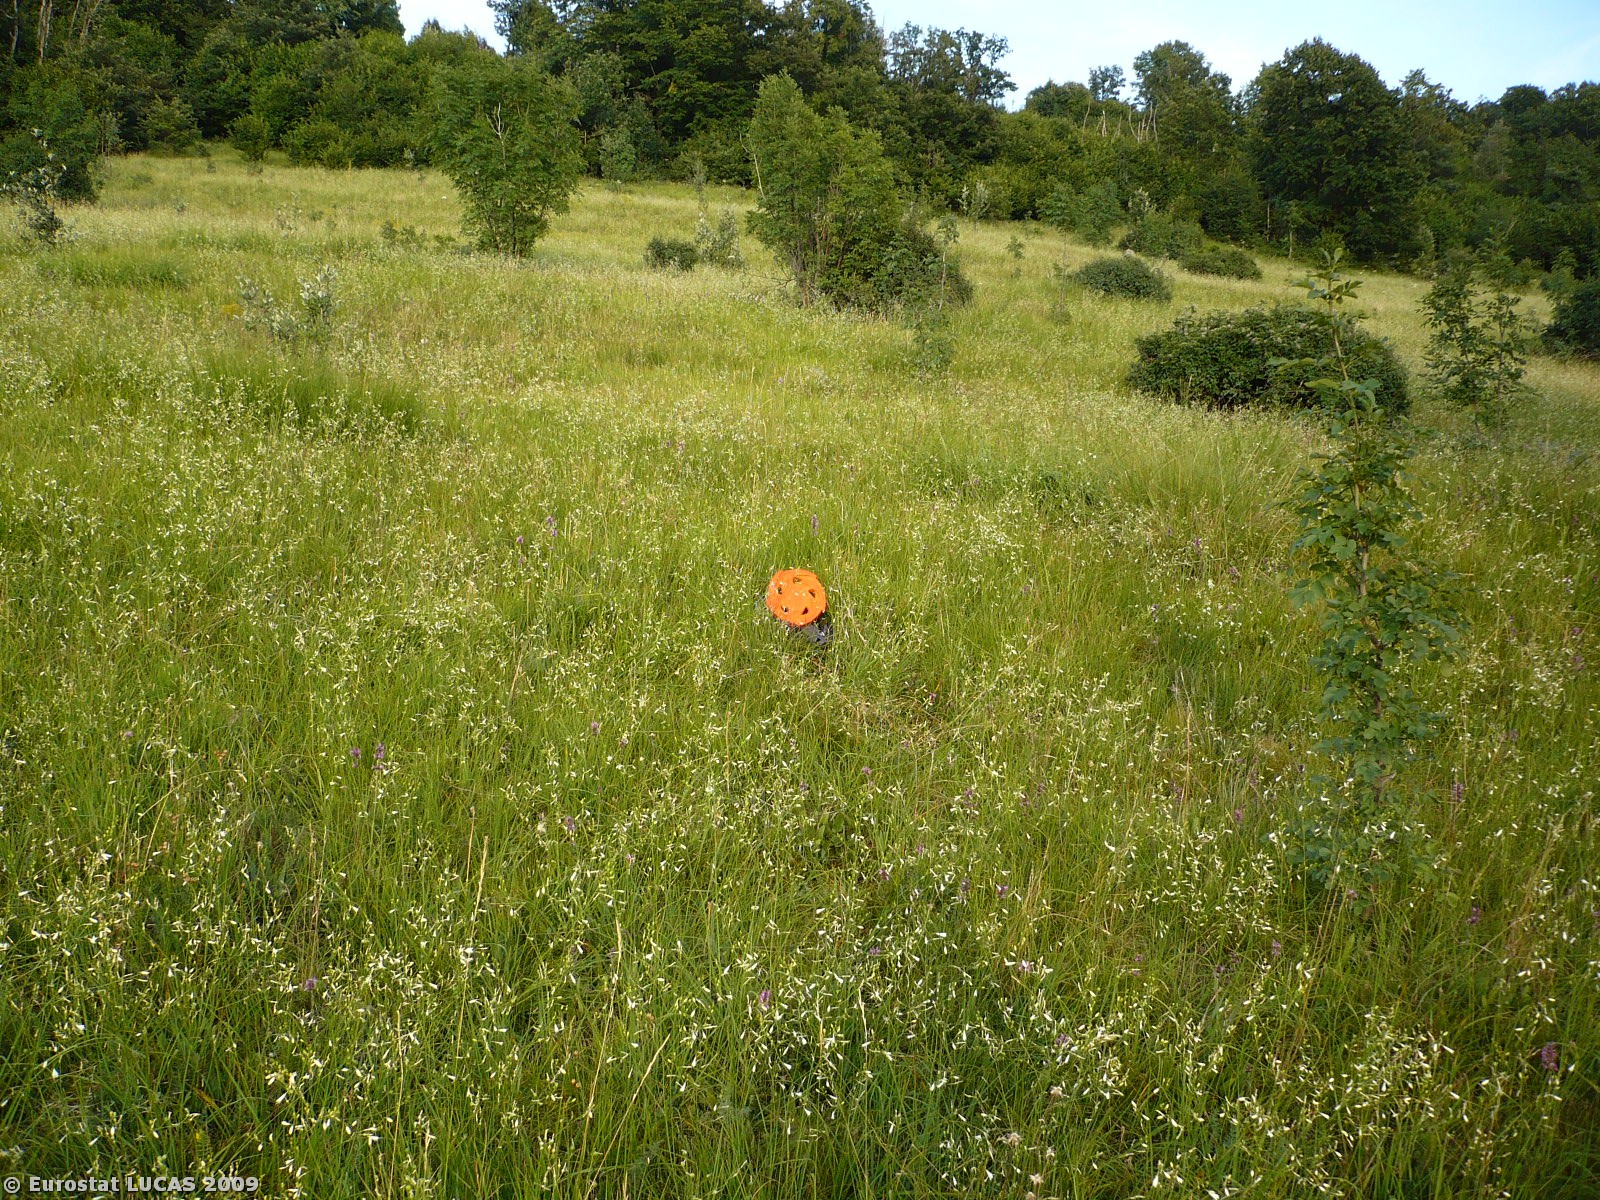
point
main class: Grassland
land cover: Grassland with sparse tree/shrub cover
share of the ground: > 75 %
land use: Unused
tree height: > 5 m
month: July
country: SI
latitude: 45.6337
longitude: 14.2930
